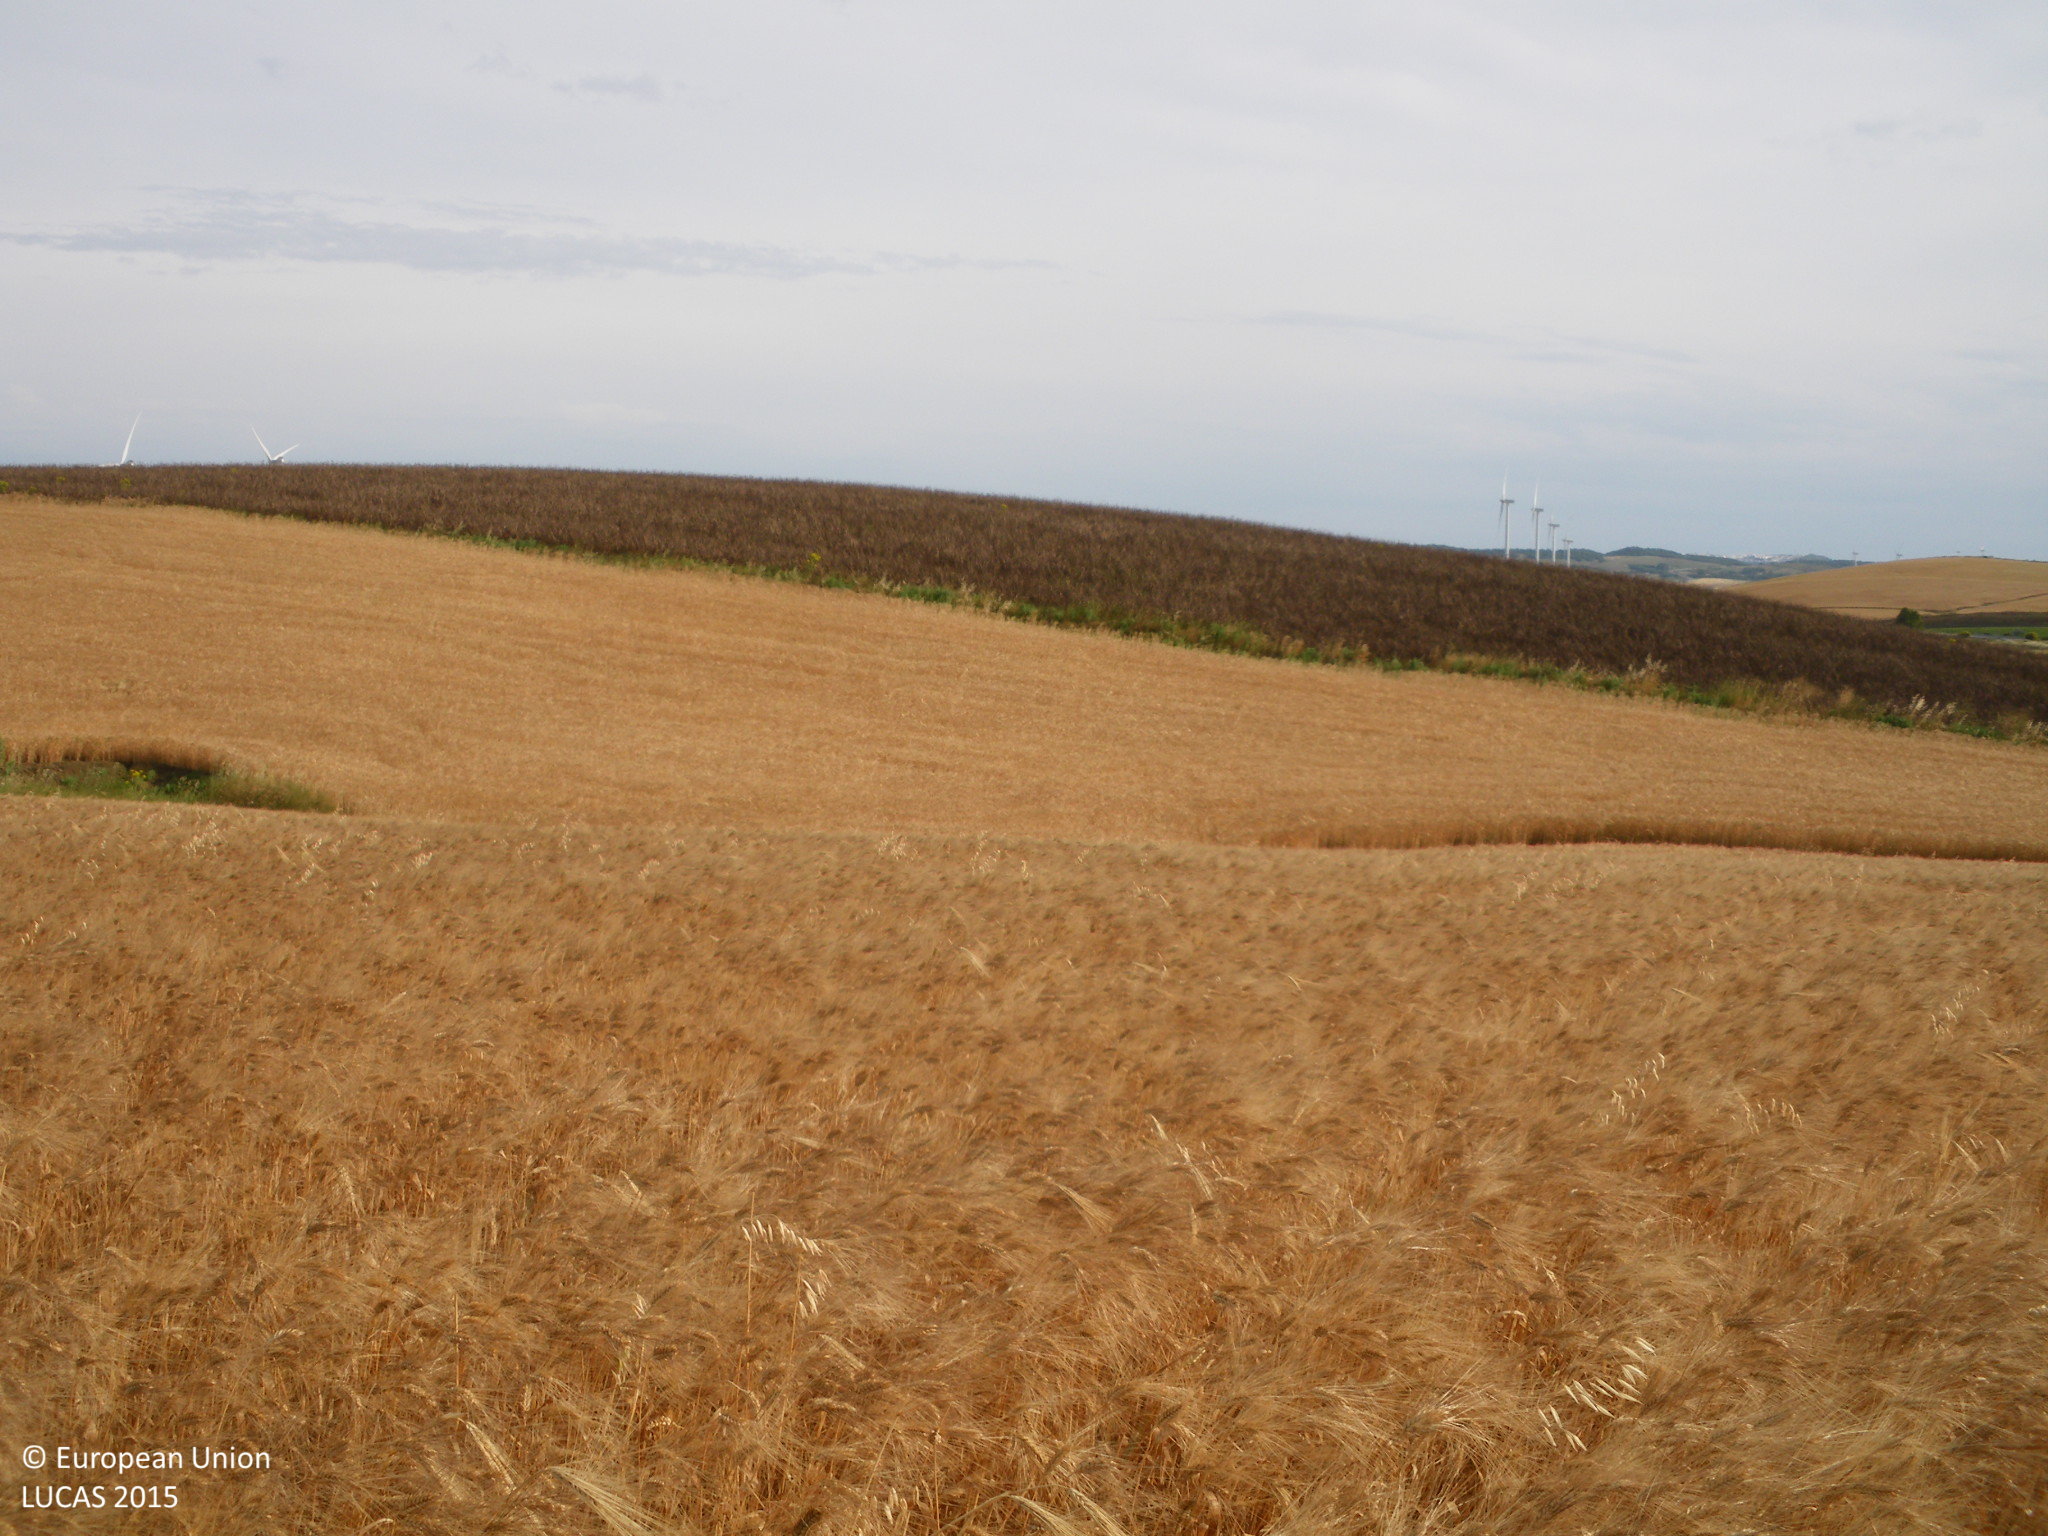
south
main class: Cropland
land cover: Durum wheat
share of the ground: > 75 %
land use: Agriculture (excluding fallow land and kitchen gardens)
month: May
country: ES
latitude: 36.3589
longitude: -5.9274
